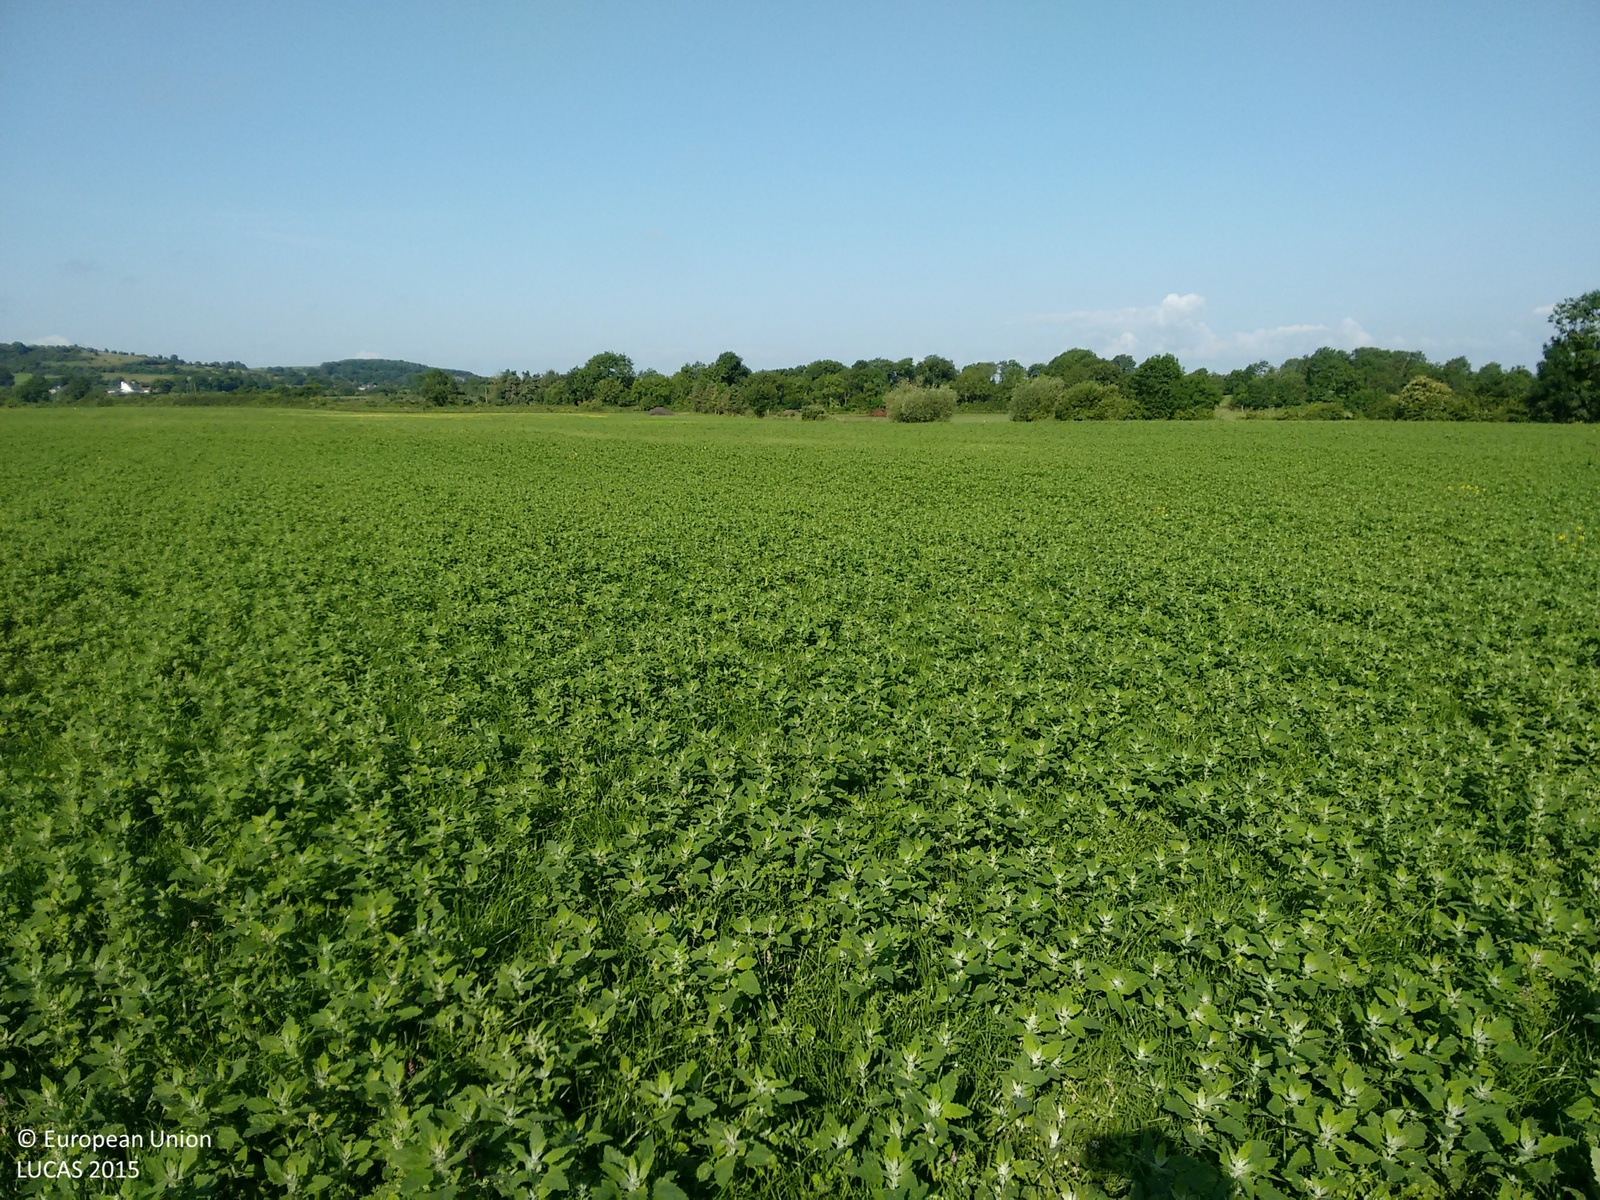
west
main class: Cropland
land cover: Temporary grasslands
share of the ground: > 75 %
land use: Agriculture (excluding fallow land and kitchen gardens)
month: July
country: IE
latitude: 52.5782
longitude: -7.7122
